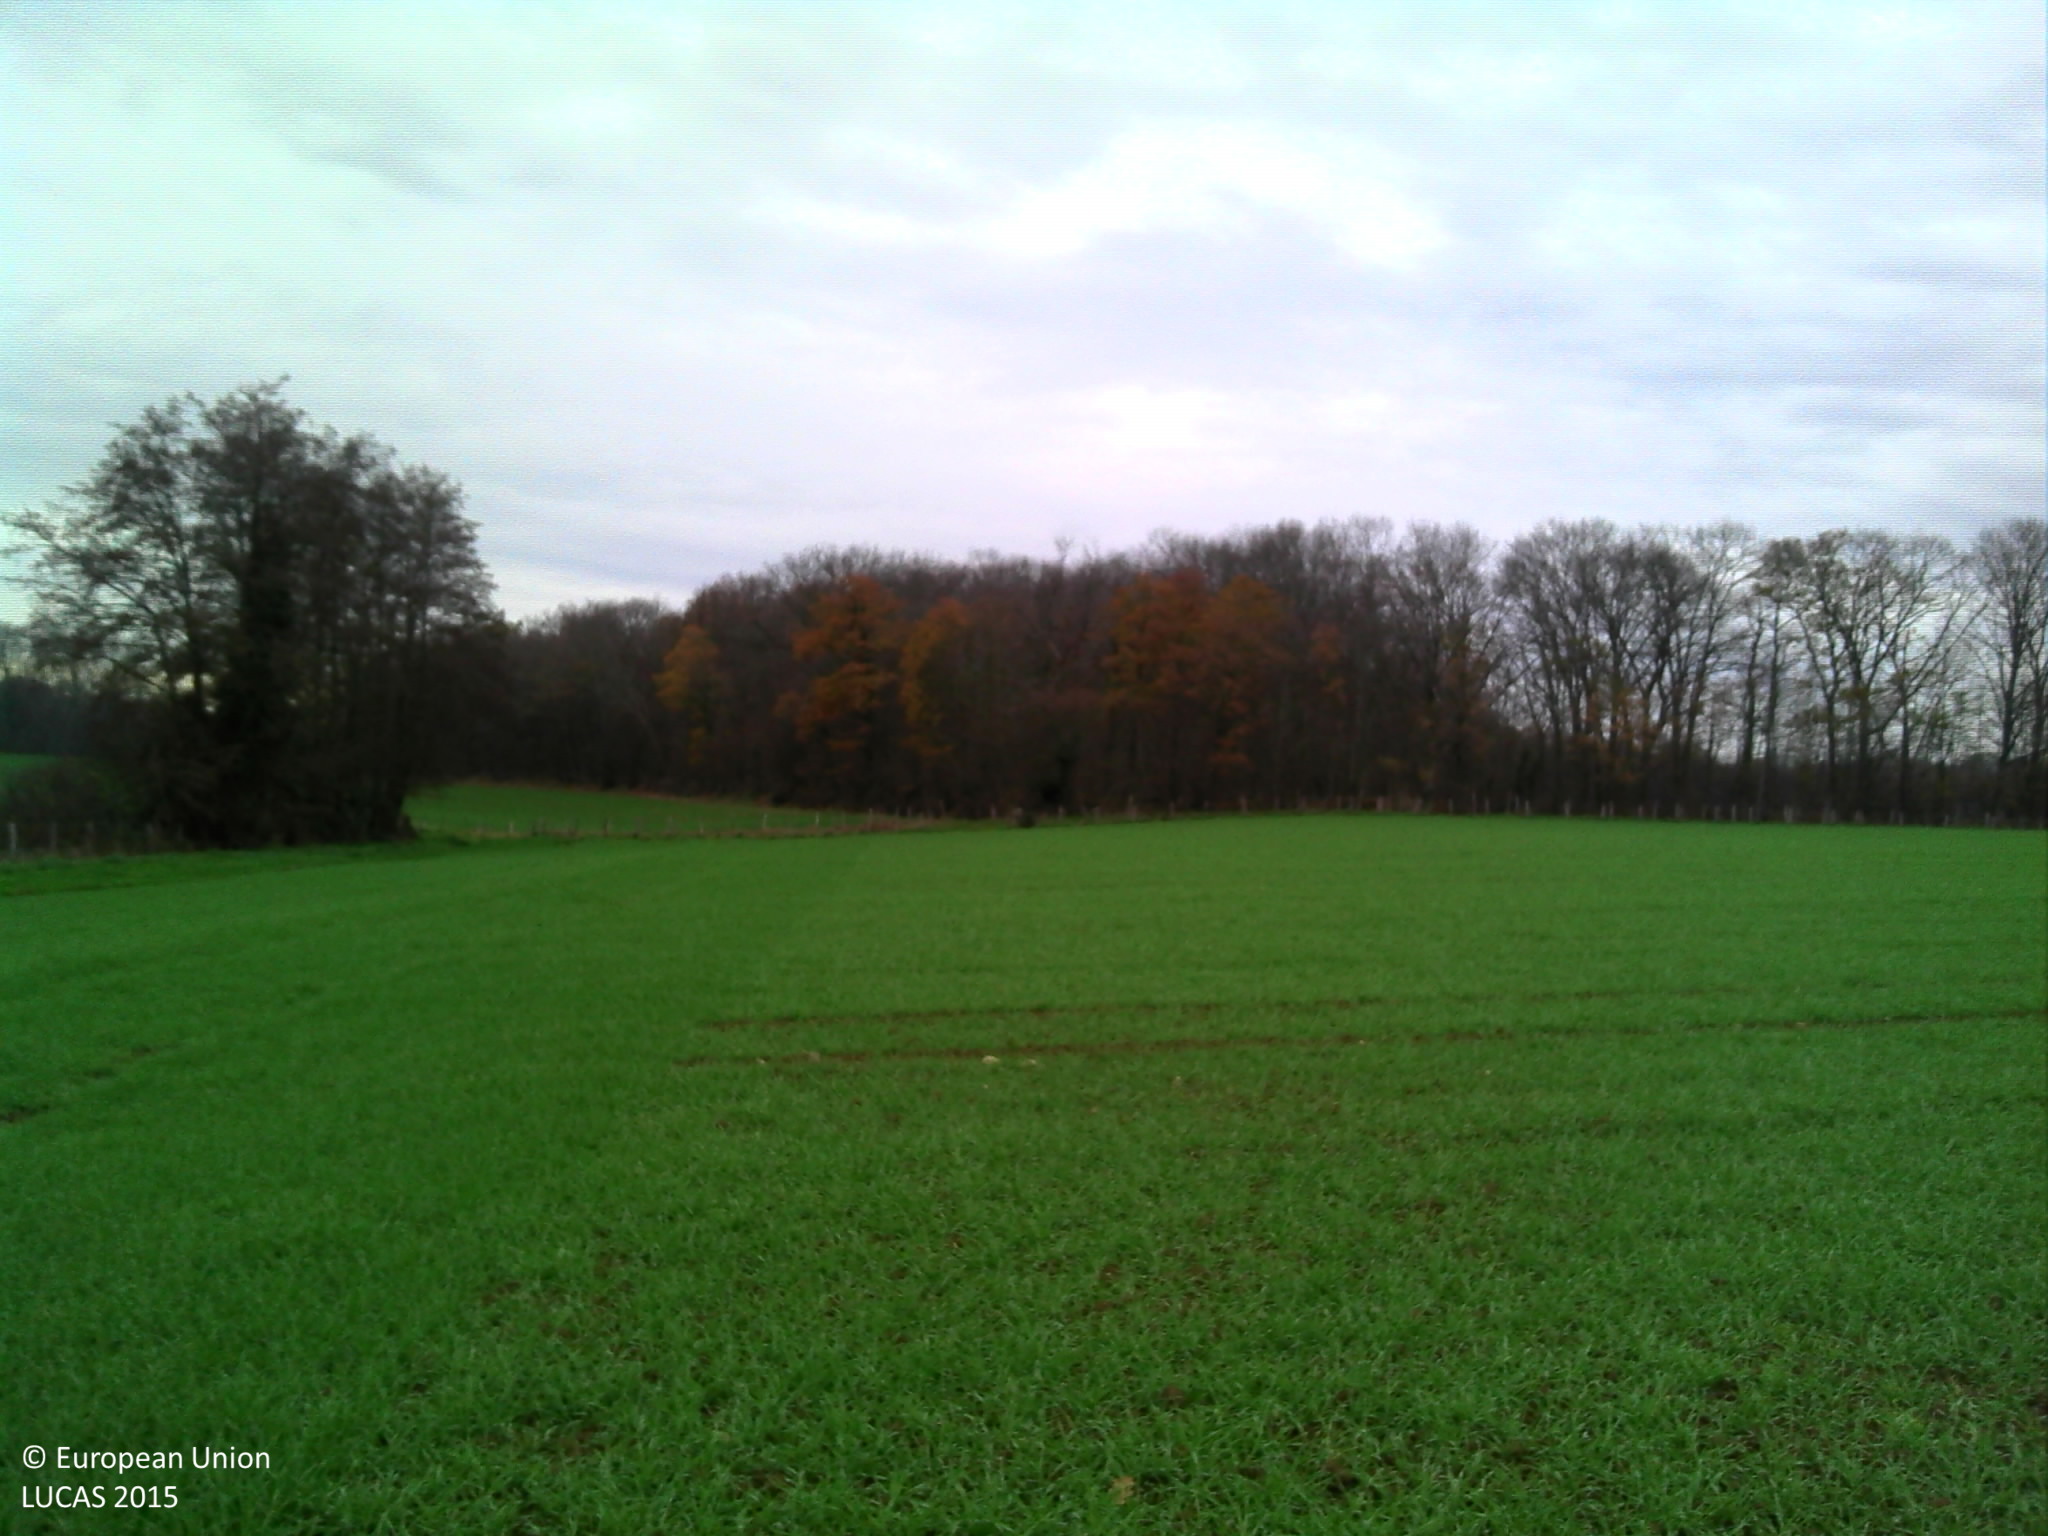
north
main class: Cropland
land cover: Common wheat
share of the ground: > 75 %
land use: Agriculture (excluding fallow land and kitchen gardens)
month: December
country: FR
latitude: 46.1329
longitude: 5.1493
